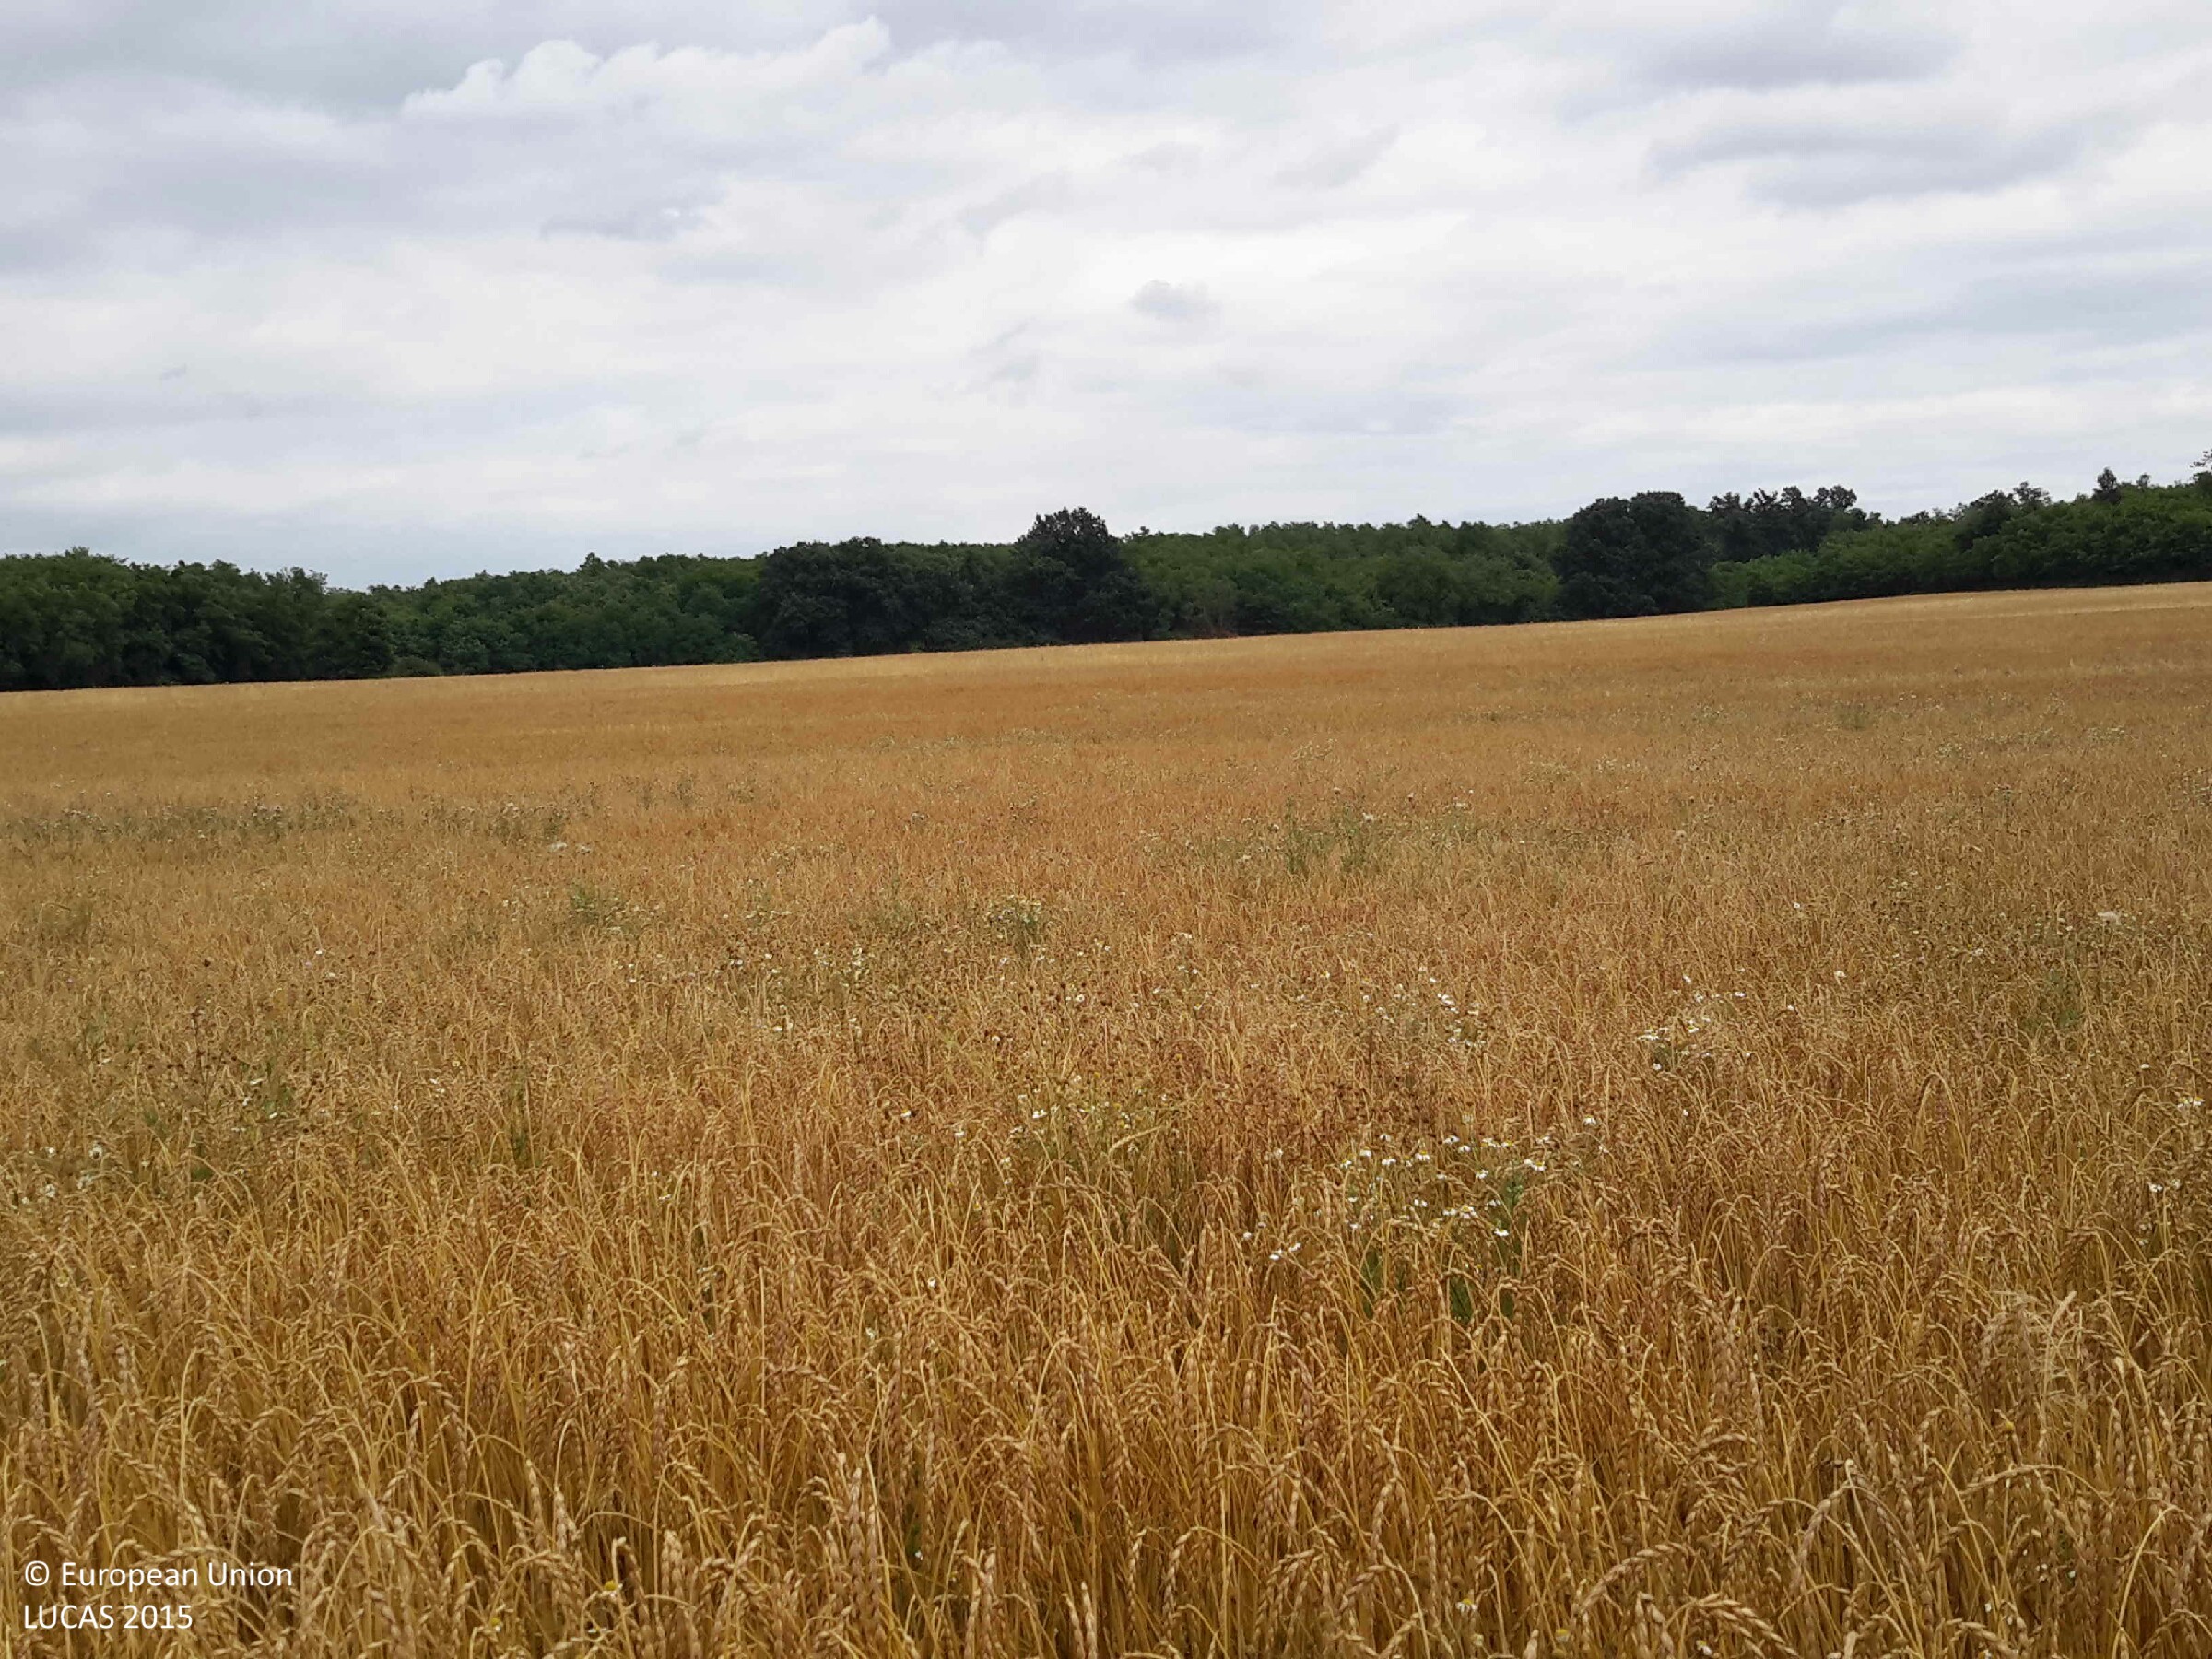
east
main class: Cropland
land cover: Durum wheat
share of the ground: > 75 %
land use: Agriculture (excluding fallow land and kitchen gardens)
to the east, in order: Durum wheat
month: July
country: HU
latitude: 47.2785
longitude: 16.9984
